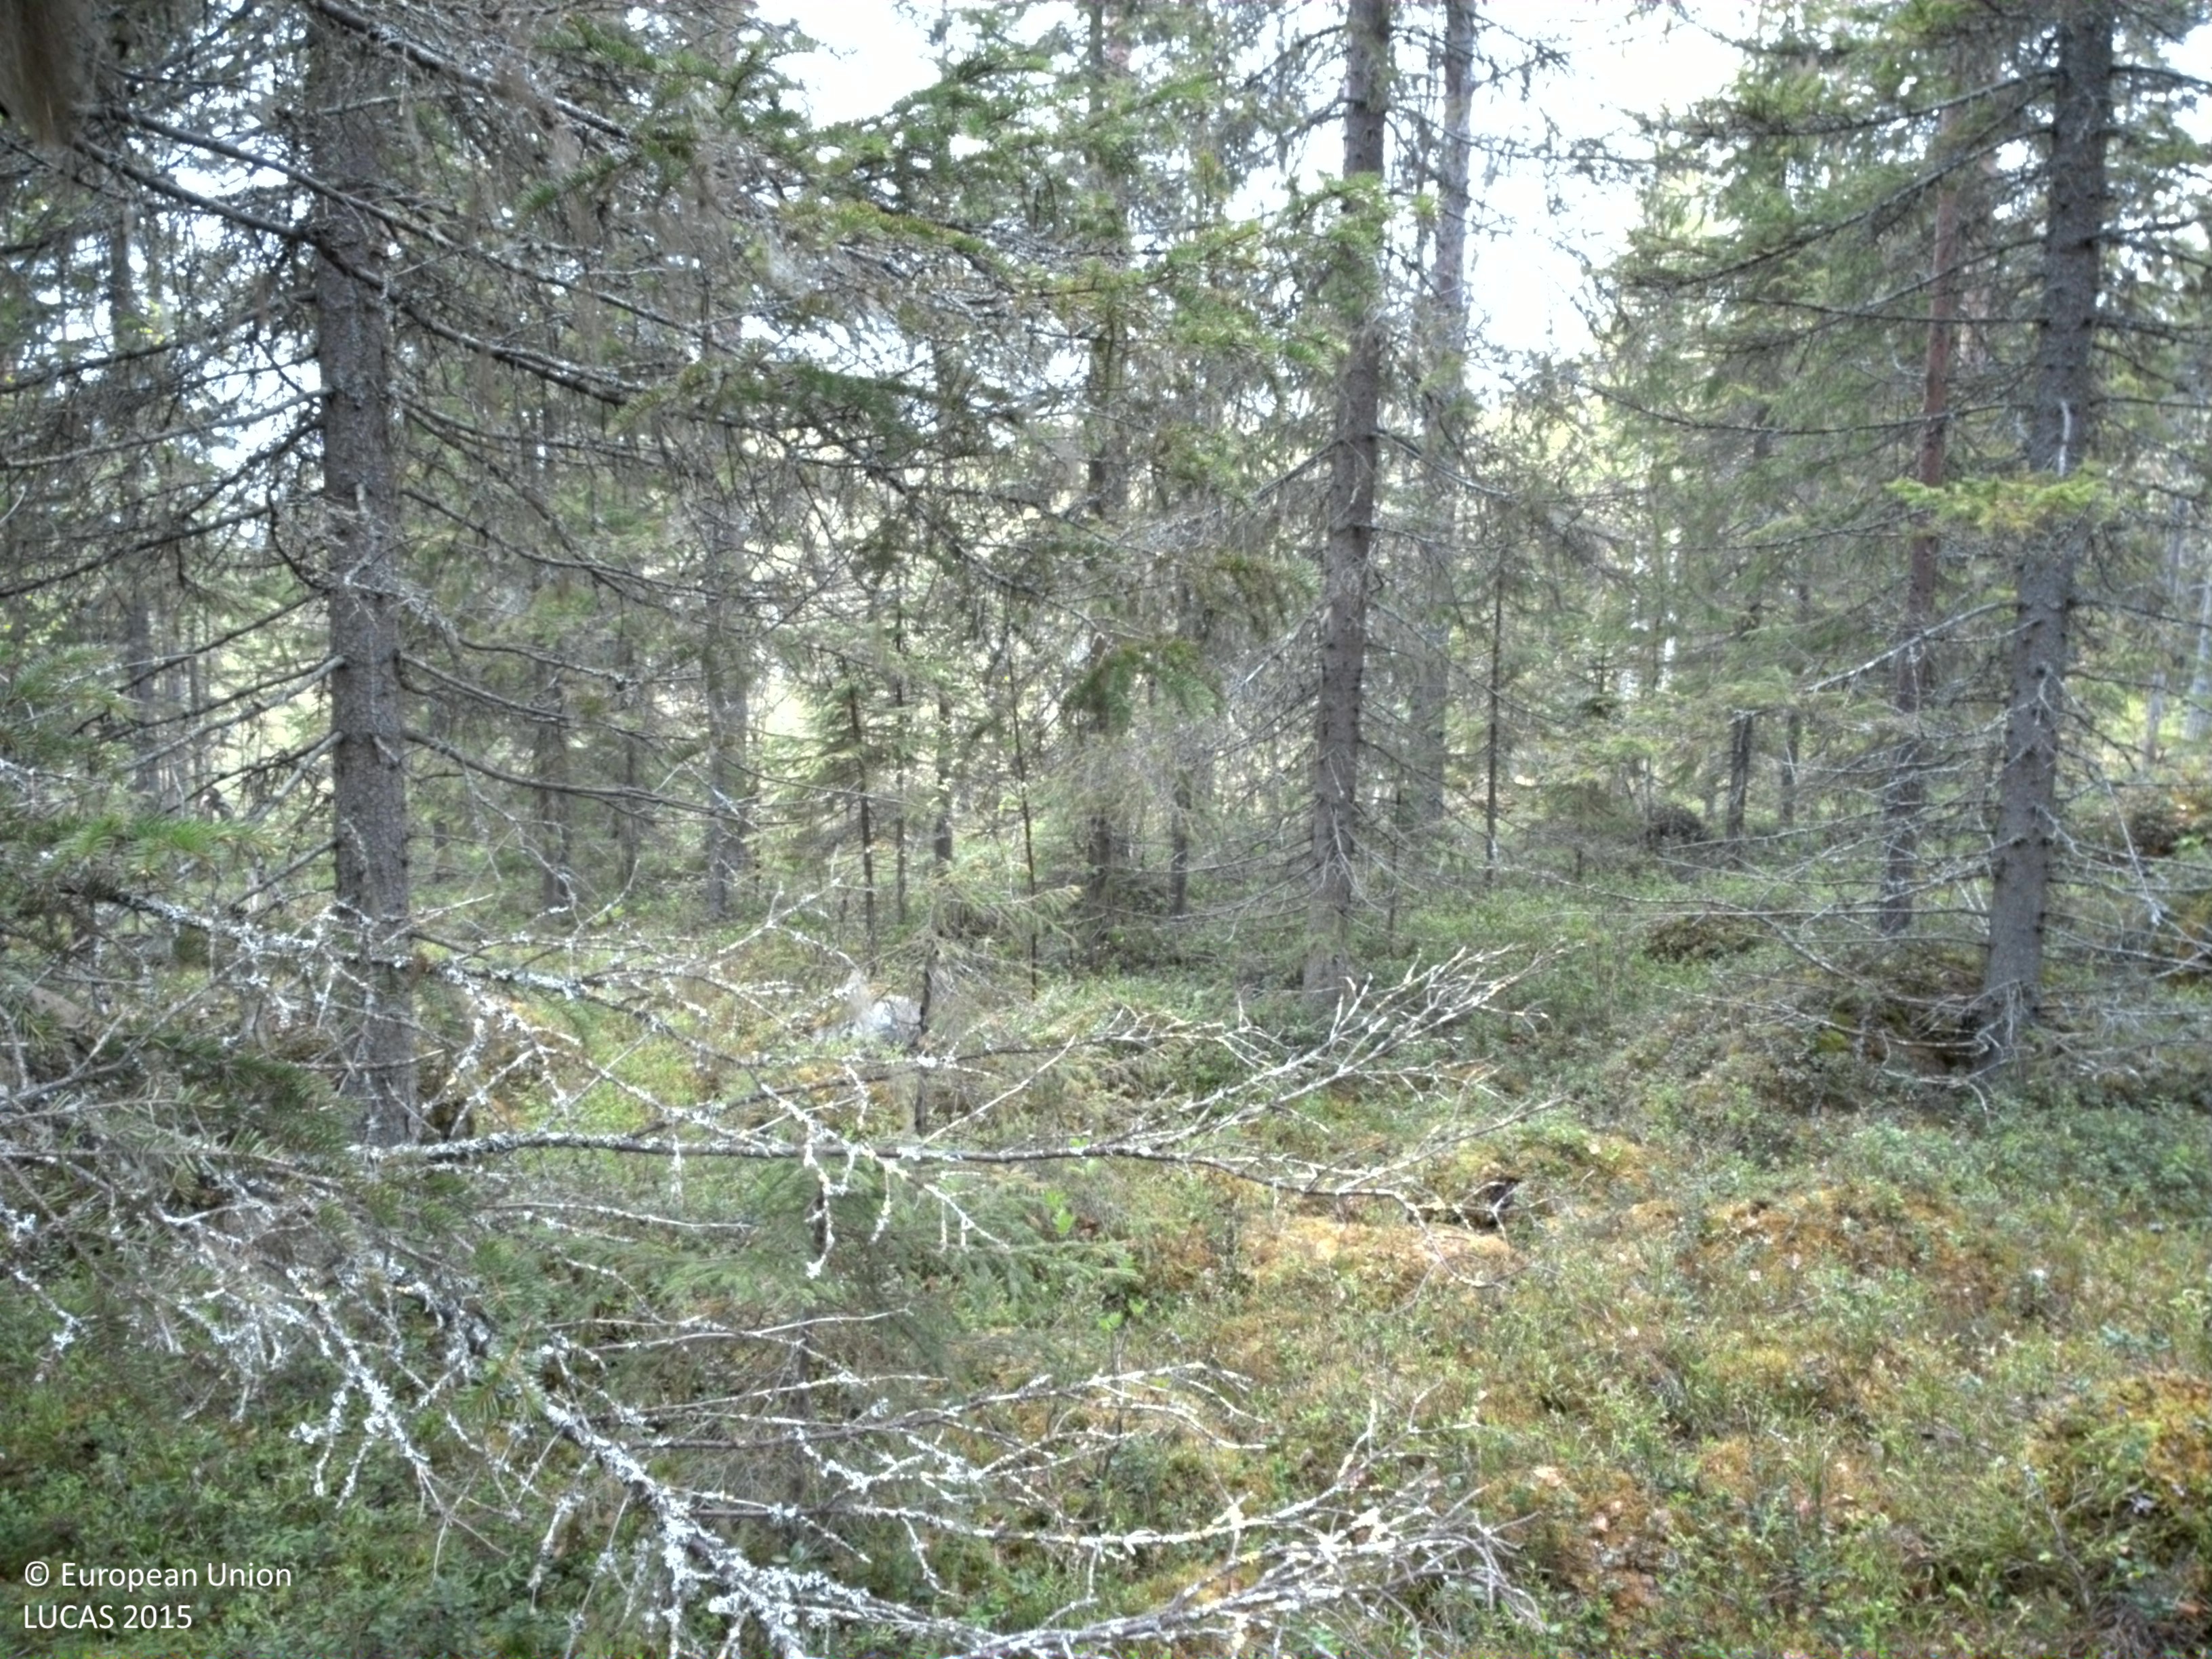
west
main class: Woodland
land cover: Pine dominated coniferous woodland
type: boreal forest
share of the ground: 50 - 75 %
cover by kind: coniferous forest trees 65 %, shrubs 30 %, broadleaved forest trees 5 %
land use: Forestry
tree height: > 5 m
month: June
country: SE
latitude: 65.9885
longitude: 23.0448
